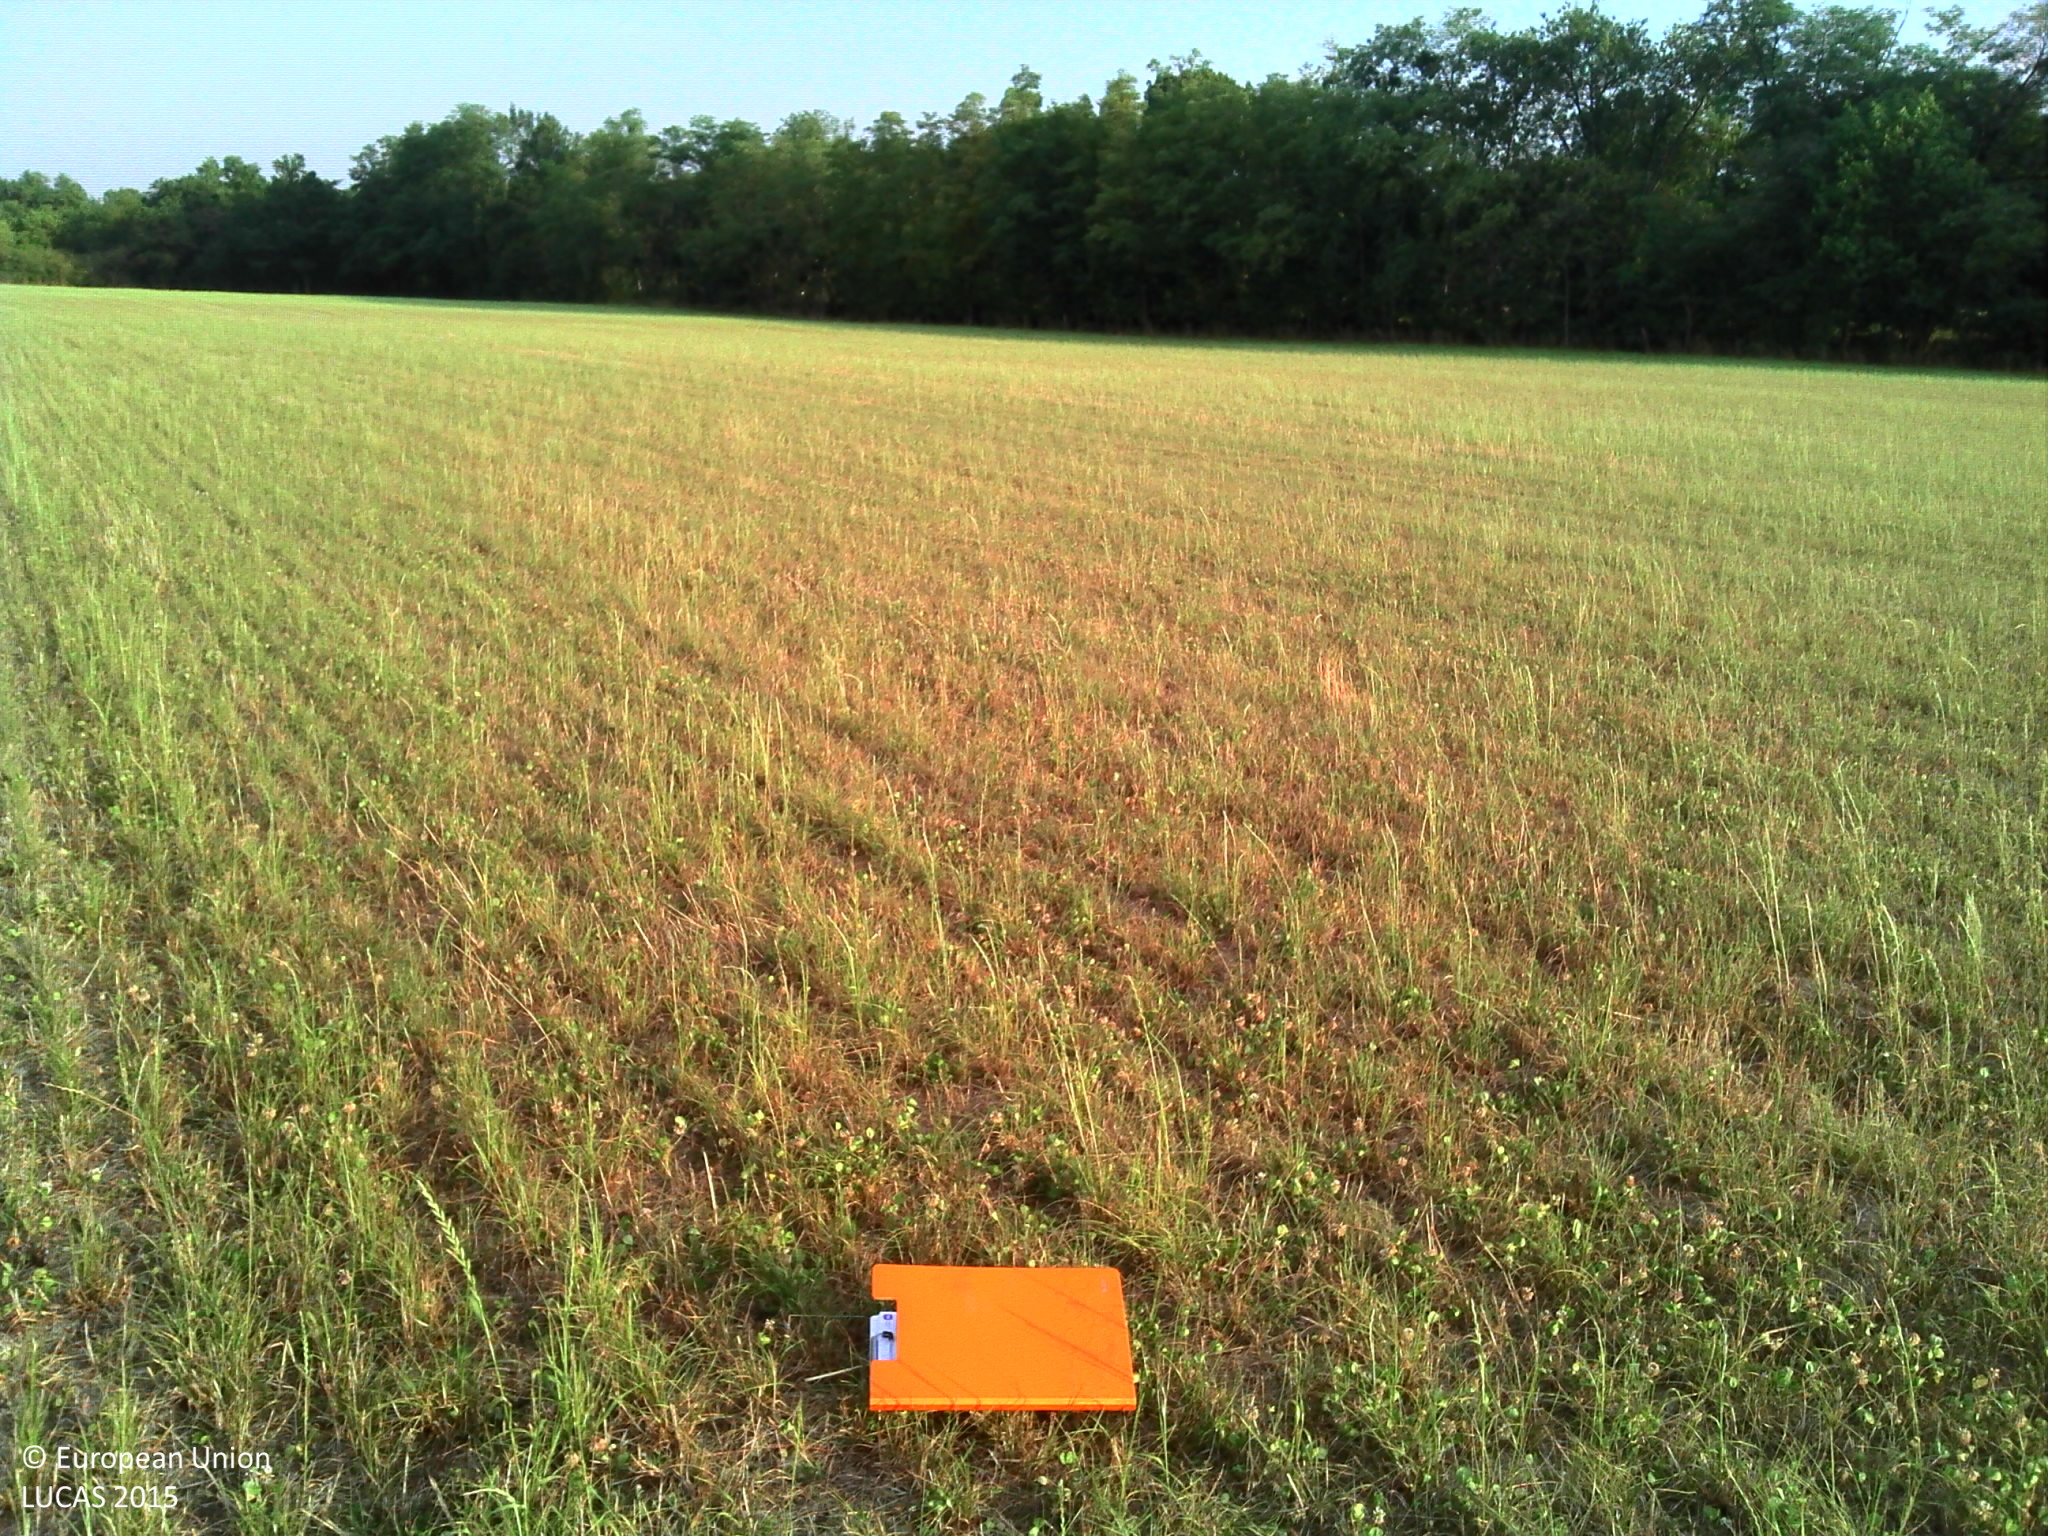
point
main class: Cropland
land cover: Temporary grasslands
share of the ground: > 75 %
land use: Agriculture (excluding fallow land and kitchen gardens)
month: July
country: FR
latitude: 46.7538
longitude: 3.5706
